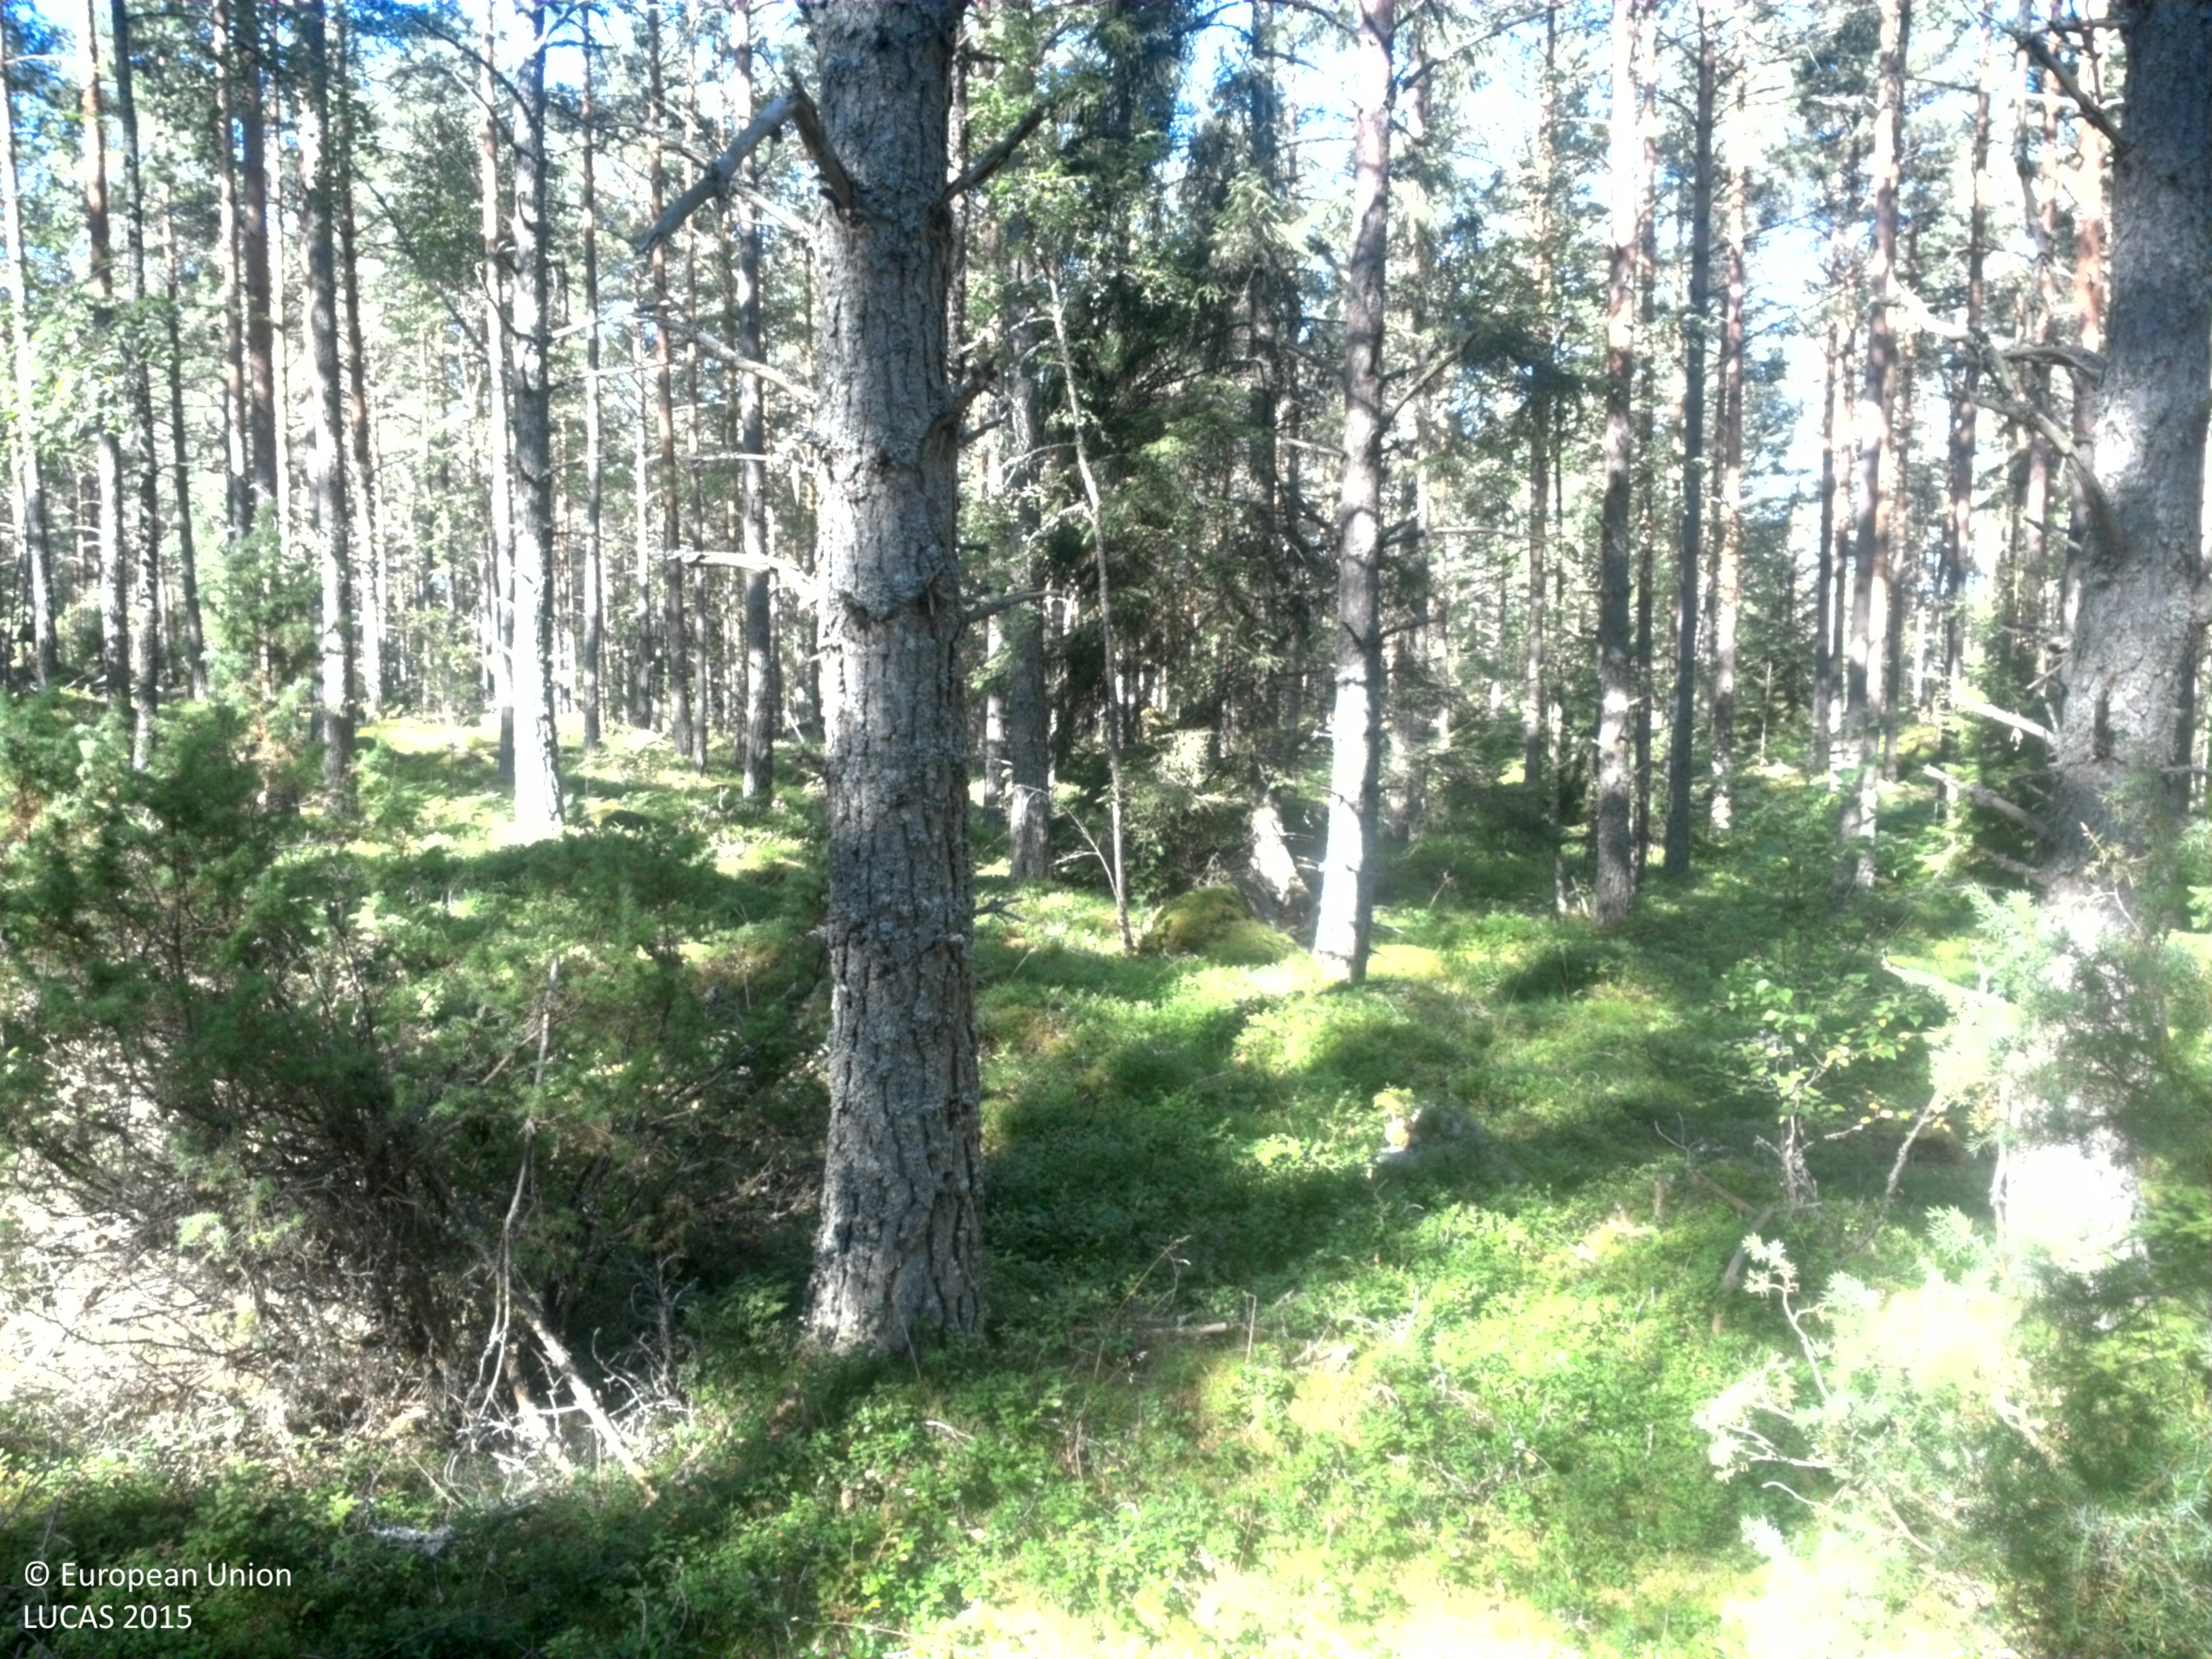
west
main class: Woodland
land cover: Pine dominated coniferous woodland
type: boreal forest
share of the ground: 50 - 75 %
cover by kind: coniferous forest trees 70 %, shrubs 25 %, lichens and mosses 5 %
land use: Forestry
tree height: > 5 m
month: August
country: SE
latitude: 59.7651
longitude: 17.1325
